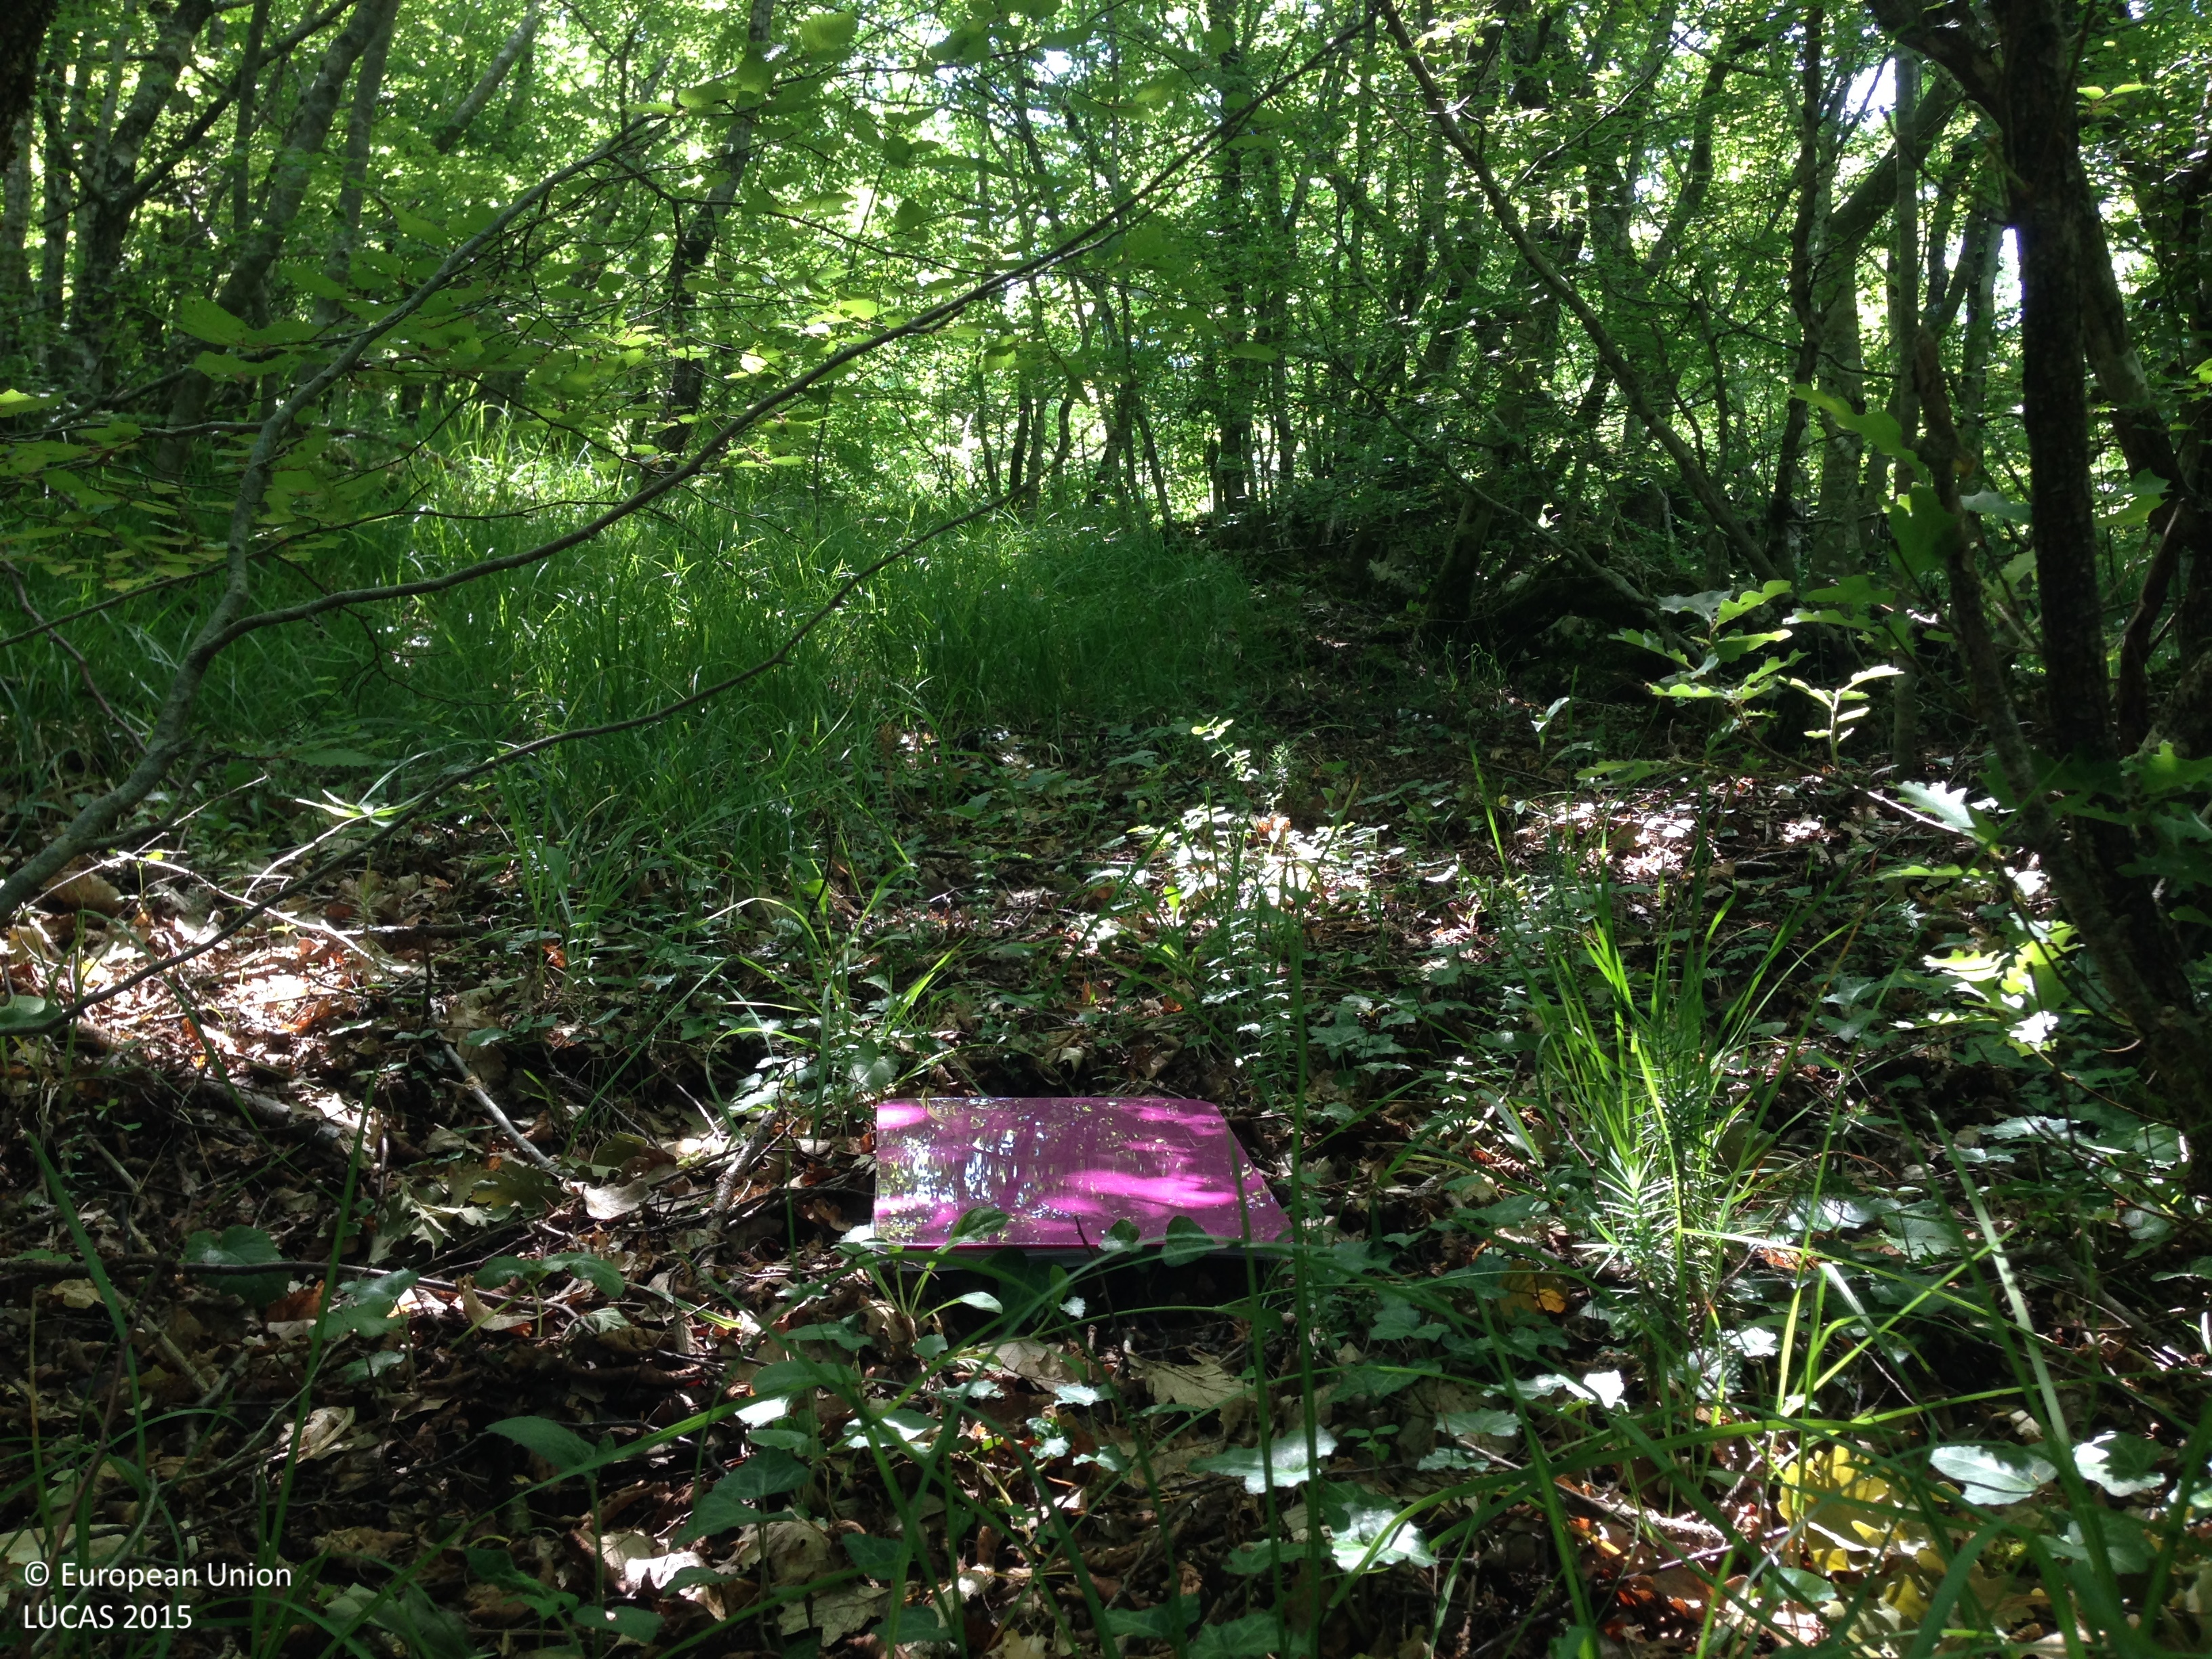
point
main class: Woodland
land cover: Broadleaved woodland
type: thermophilous deciduous forest
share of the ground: > 75 %
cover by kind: broadleaved forest trees 75 %, shrubs 10 %, herbaceous plants 5 %, consolidated bare surface 5 %, unconsolidated bare surface 5 %
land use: Semi-natural and natural areas not in use
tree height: > 5 m
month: June
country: HR
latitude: 43.7331
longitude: 16.4601
